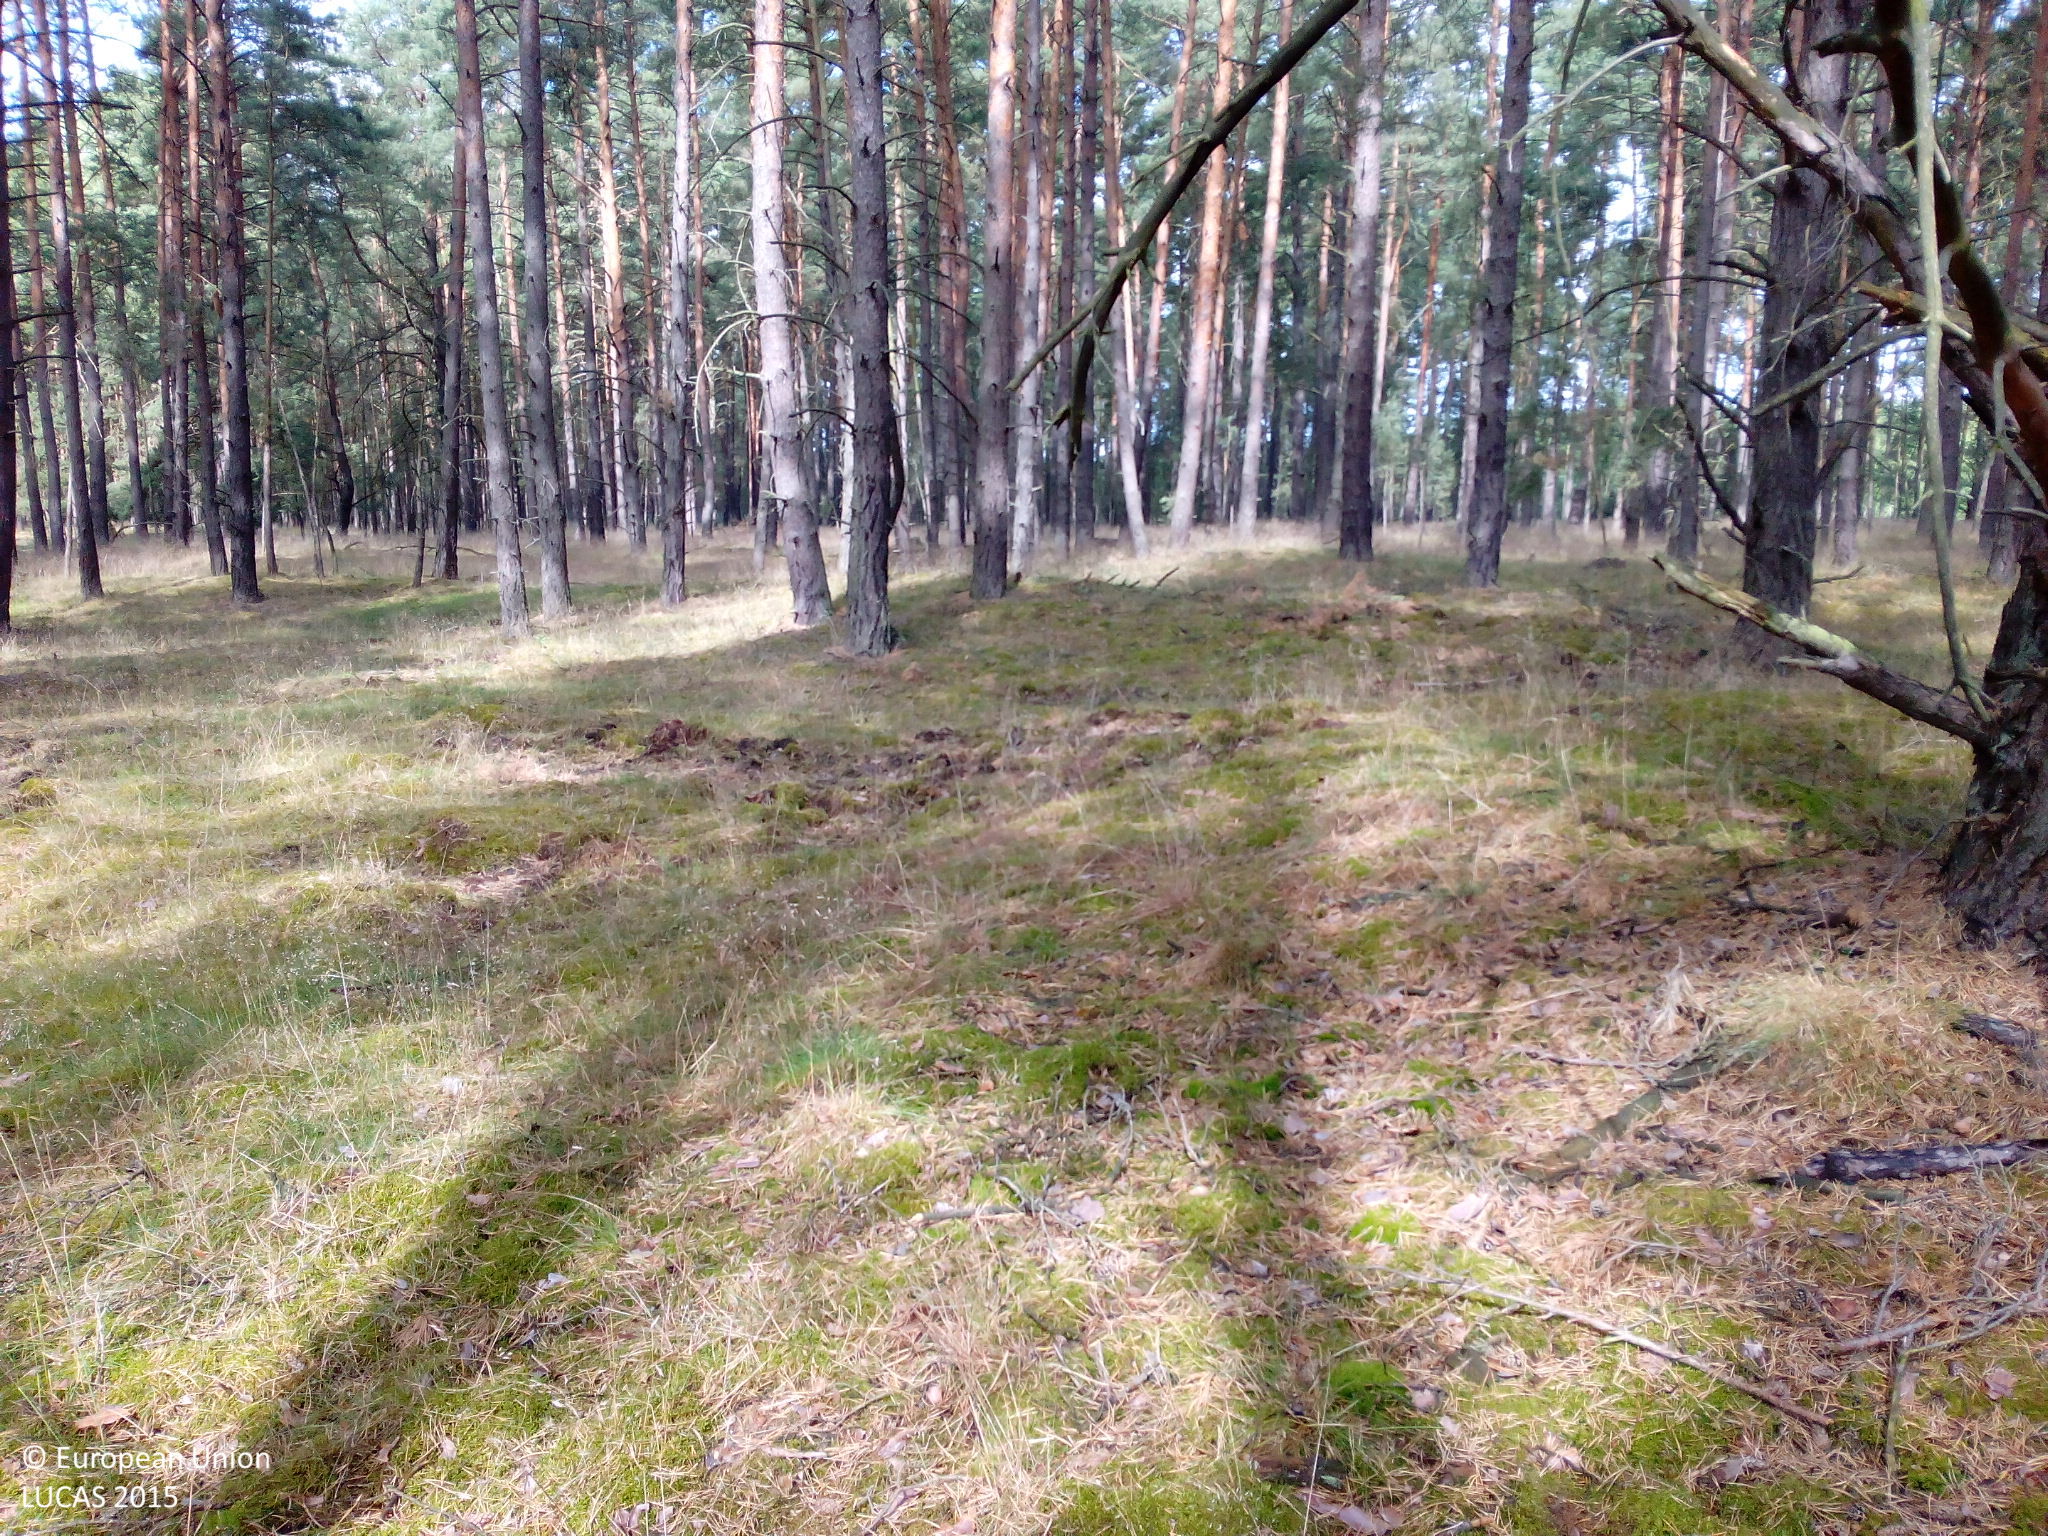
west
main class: Woodland
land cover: Pine dominated coniferous woodland
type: hemiboreal forest and nemoral coniferous forest and mixed broadleaved-coniferous forest
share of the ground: > 75 %
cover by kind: coniferous forest trees 80 %, herbaceous plants 10 %, lichens and mosses 10 %
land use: Forestry
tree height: > 5 m
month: July
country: DE
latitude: 52.8103
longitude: 13.5458
